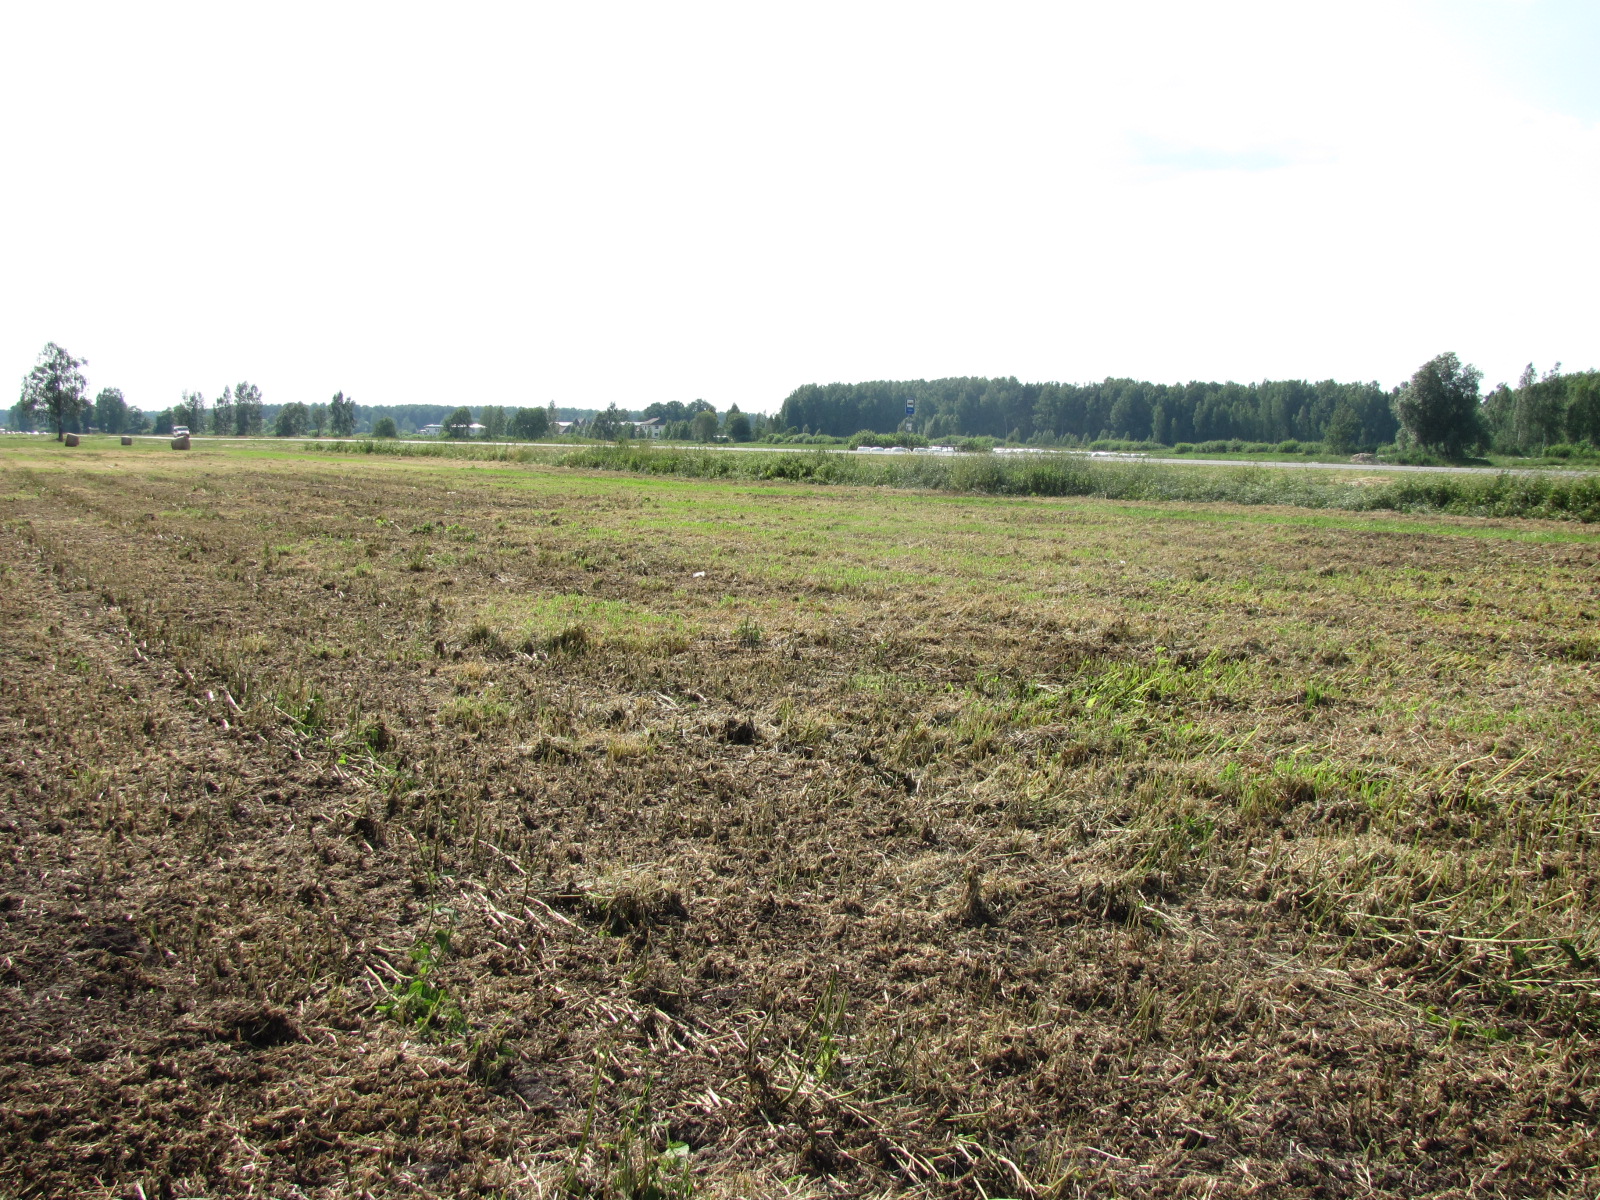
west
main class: Grassland
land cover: Grassland without tree/shrub cover
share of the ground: 10 - 25 %
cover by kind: unconsolidated bare surface 85 %, herbaceous plants 15 %
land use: Agriculture (excluding fallow land and kitchen gardens)
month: July
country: LV
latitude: 56.8939
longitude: 24.0209
